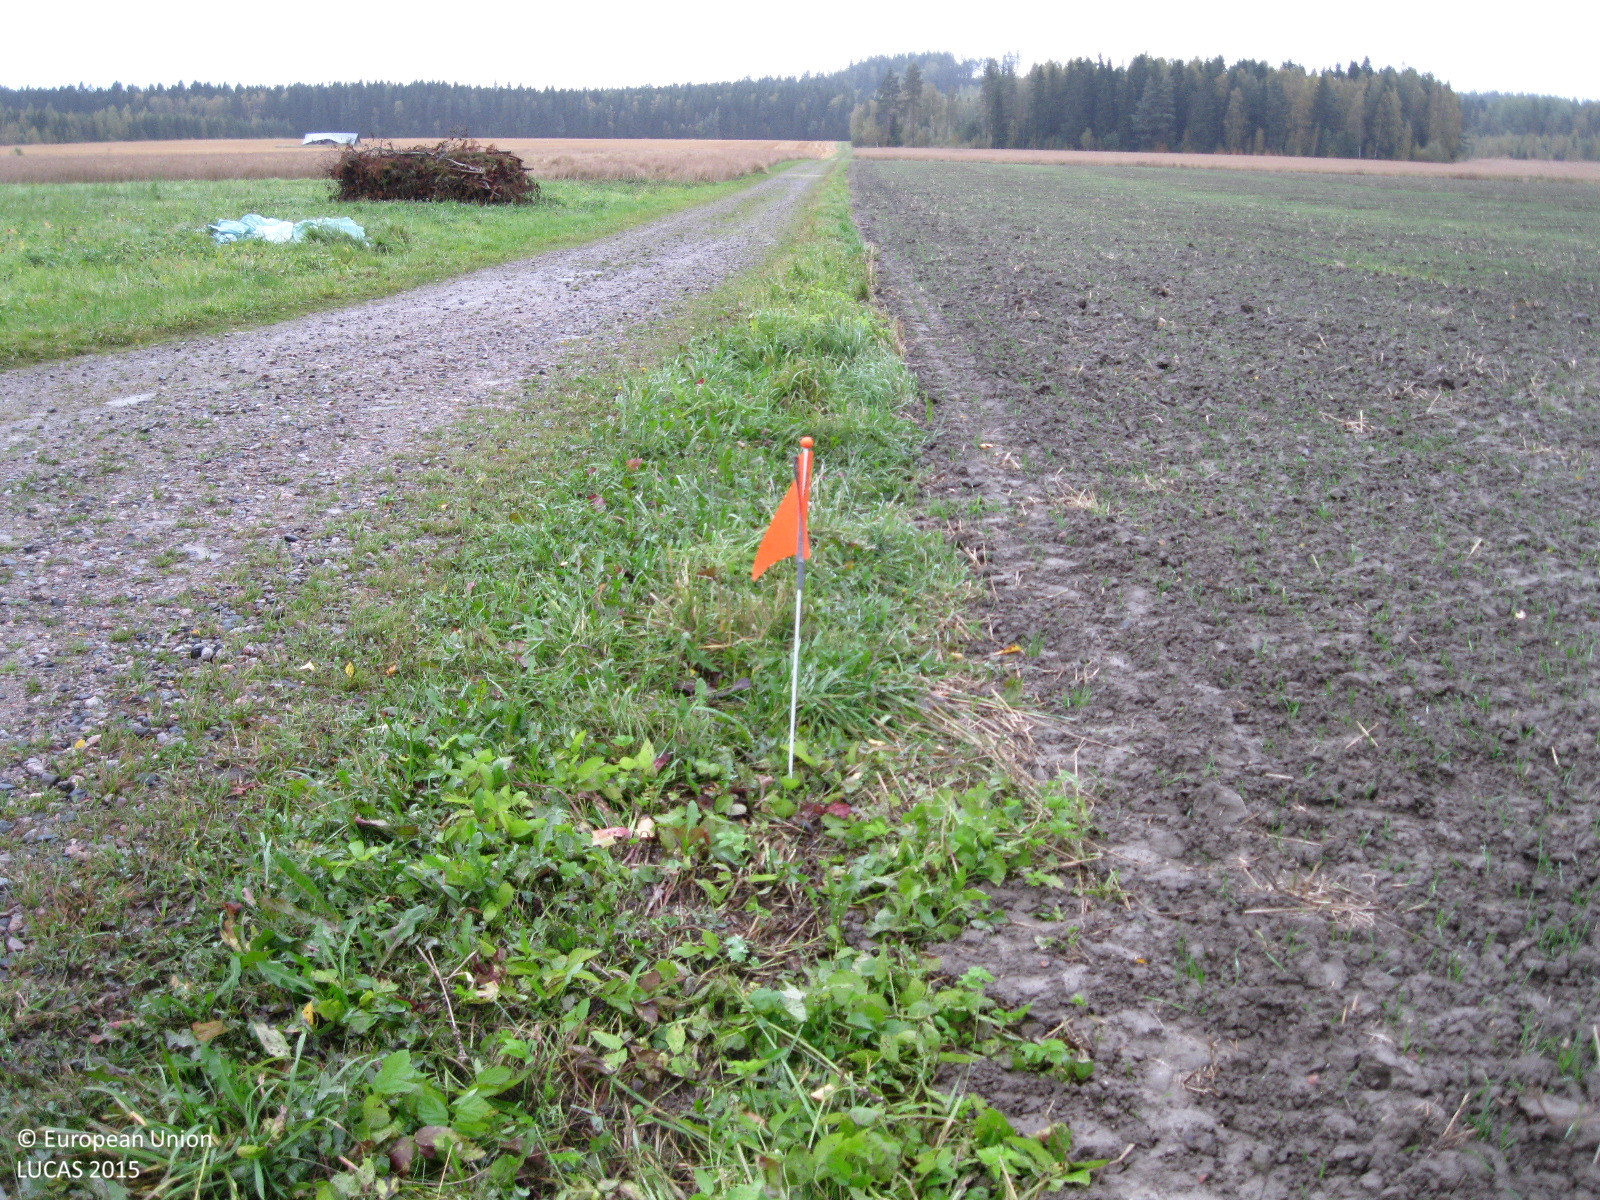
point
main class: Cropland
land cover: Common wheat
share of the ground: < 10 %
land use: Agriculture (excluding fallow land and kitchen gardens)
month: September
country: FI
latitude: 60.8160
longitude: 24.7246
